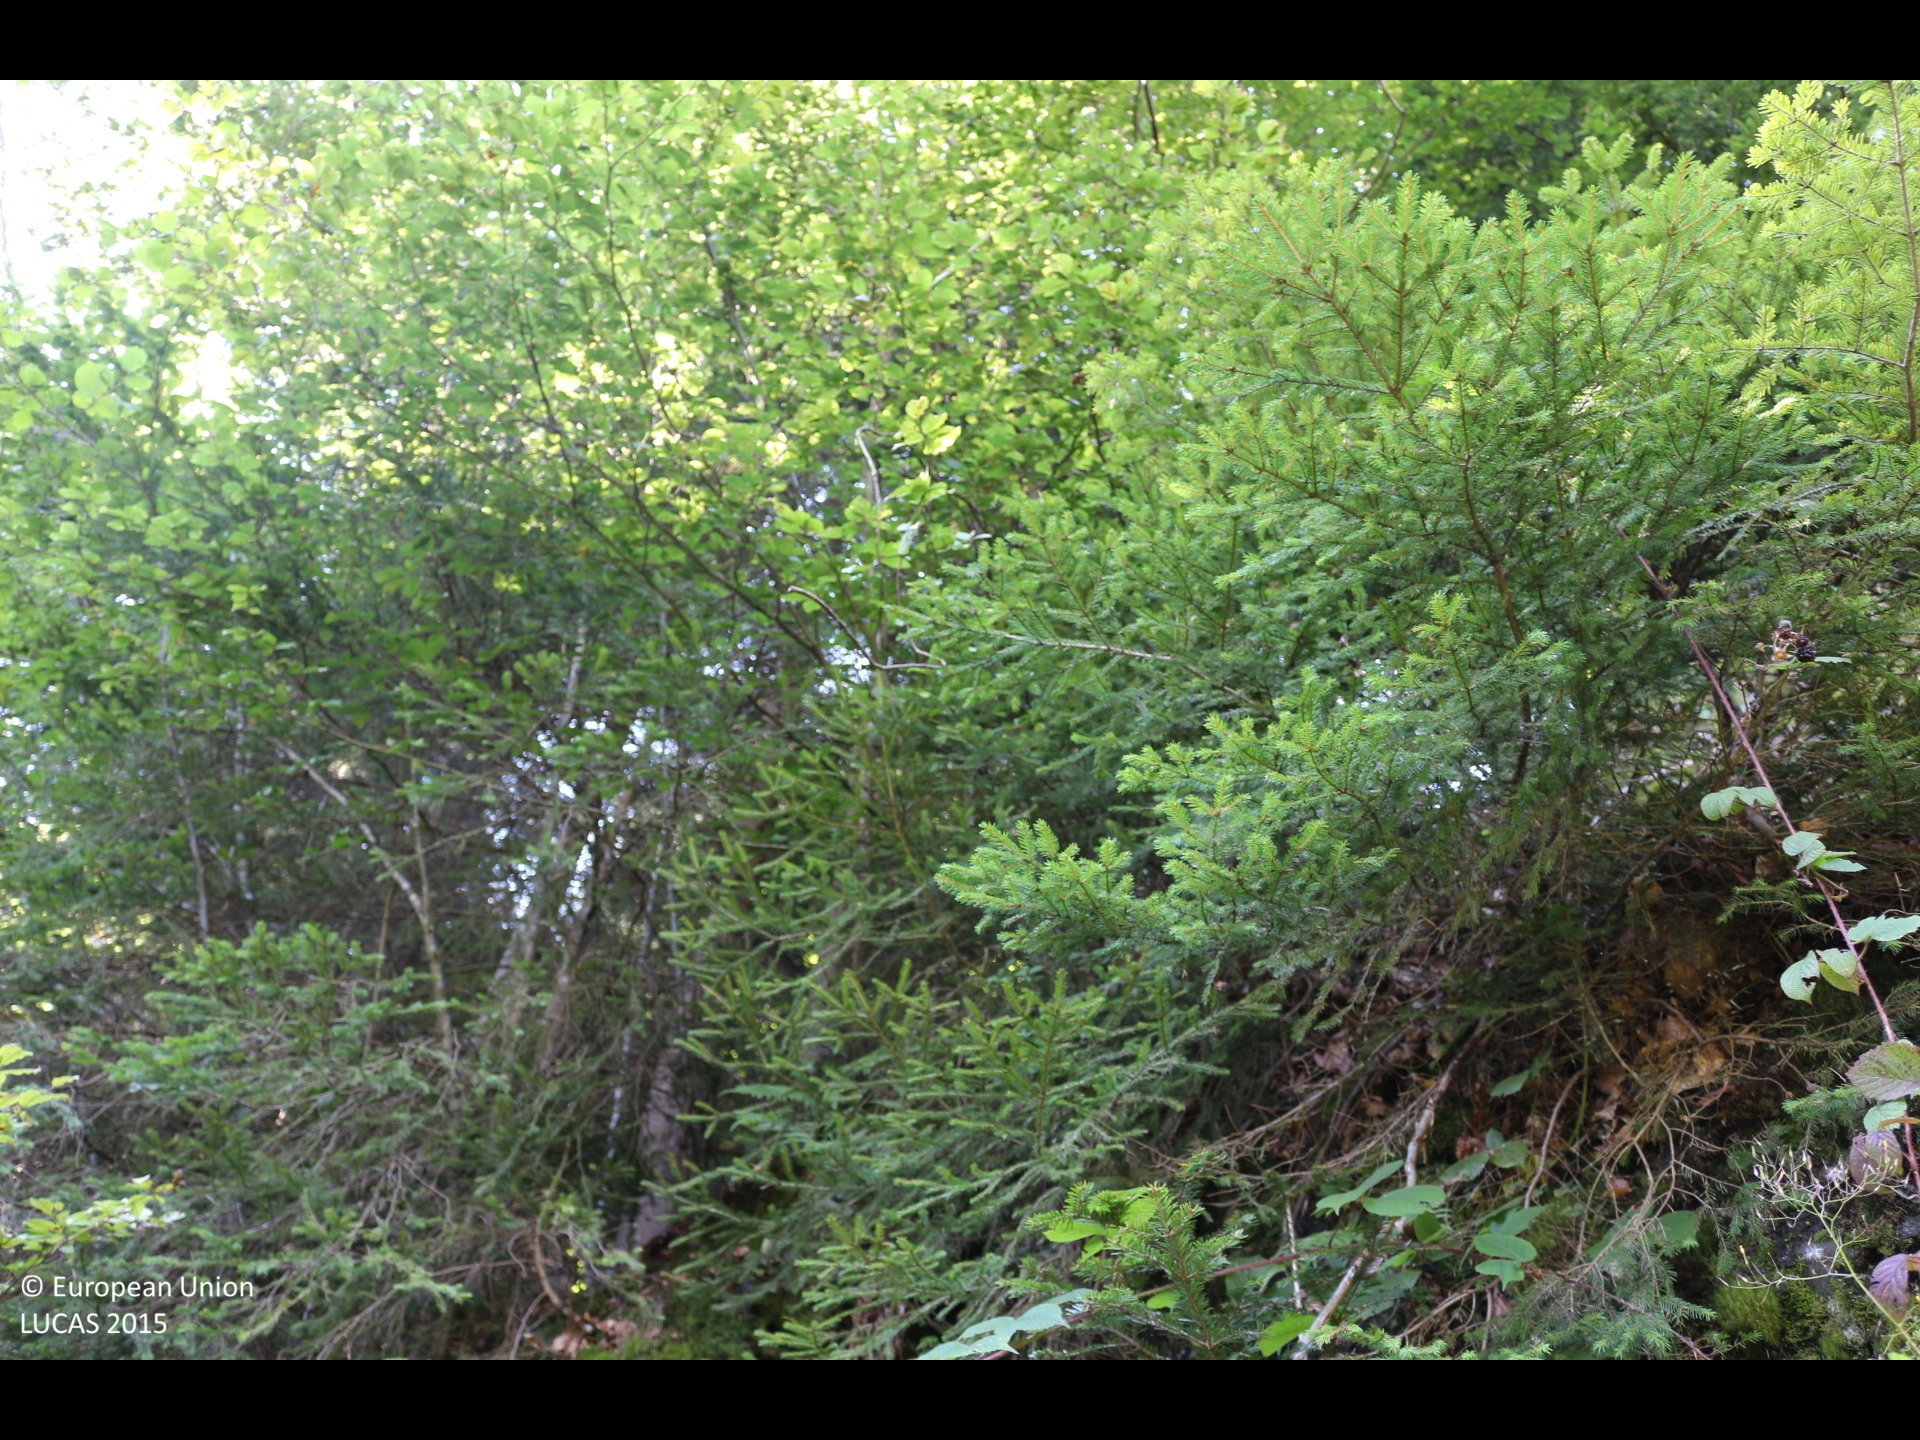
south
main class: Woodland
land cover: Spruce dominated mixed woodland
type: hemiboreal forest and nemoral coniferous forest and mixed broadleaved-coniferous forest
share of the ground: > 75 %
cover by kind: coniferous forest trees 60 %, broadleaved forest trees 40 %
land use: Forestry
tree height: > 5 m
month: August
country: AT
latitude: 46.6419
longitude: 13.3286
